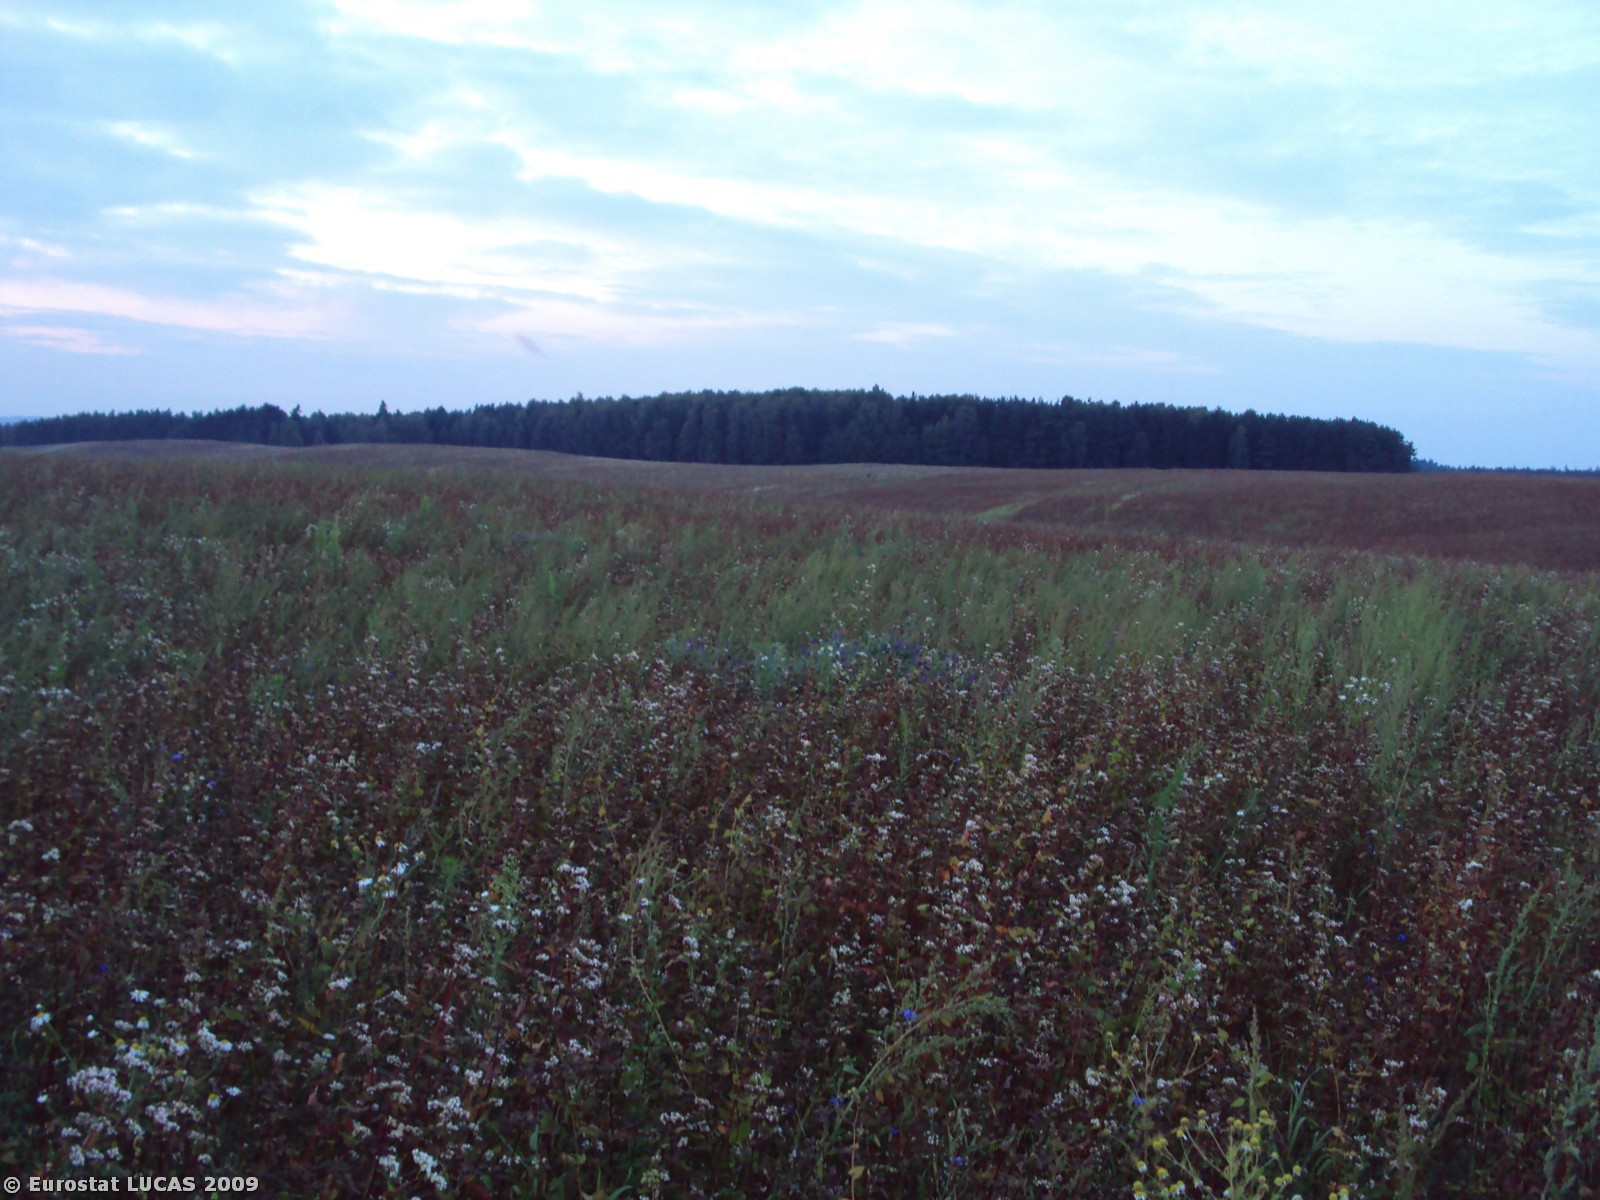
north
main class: Cropland
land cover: Other cereals
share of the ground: > 75 %
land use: Agriculture (excluding fallow land and kitchen gardens)
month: September
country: PL
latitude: 53.7611
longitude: 15.9355
